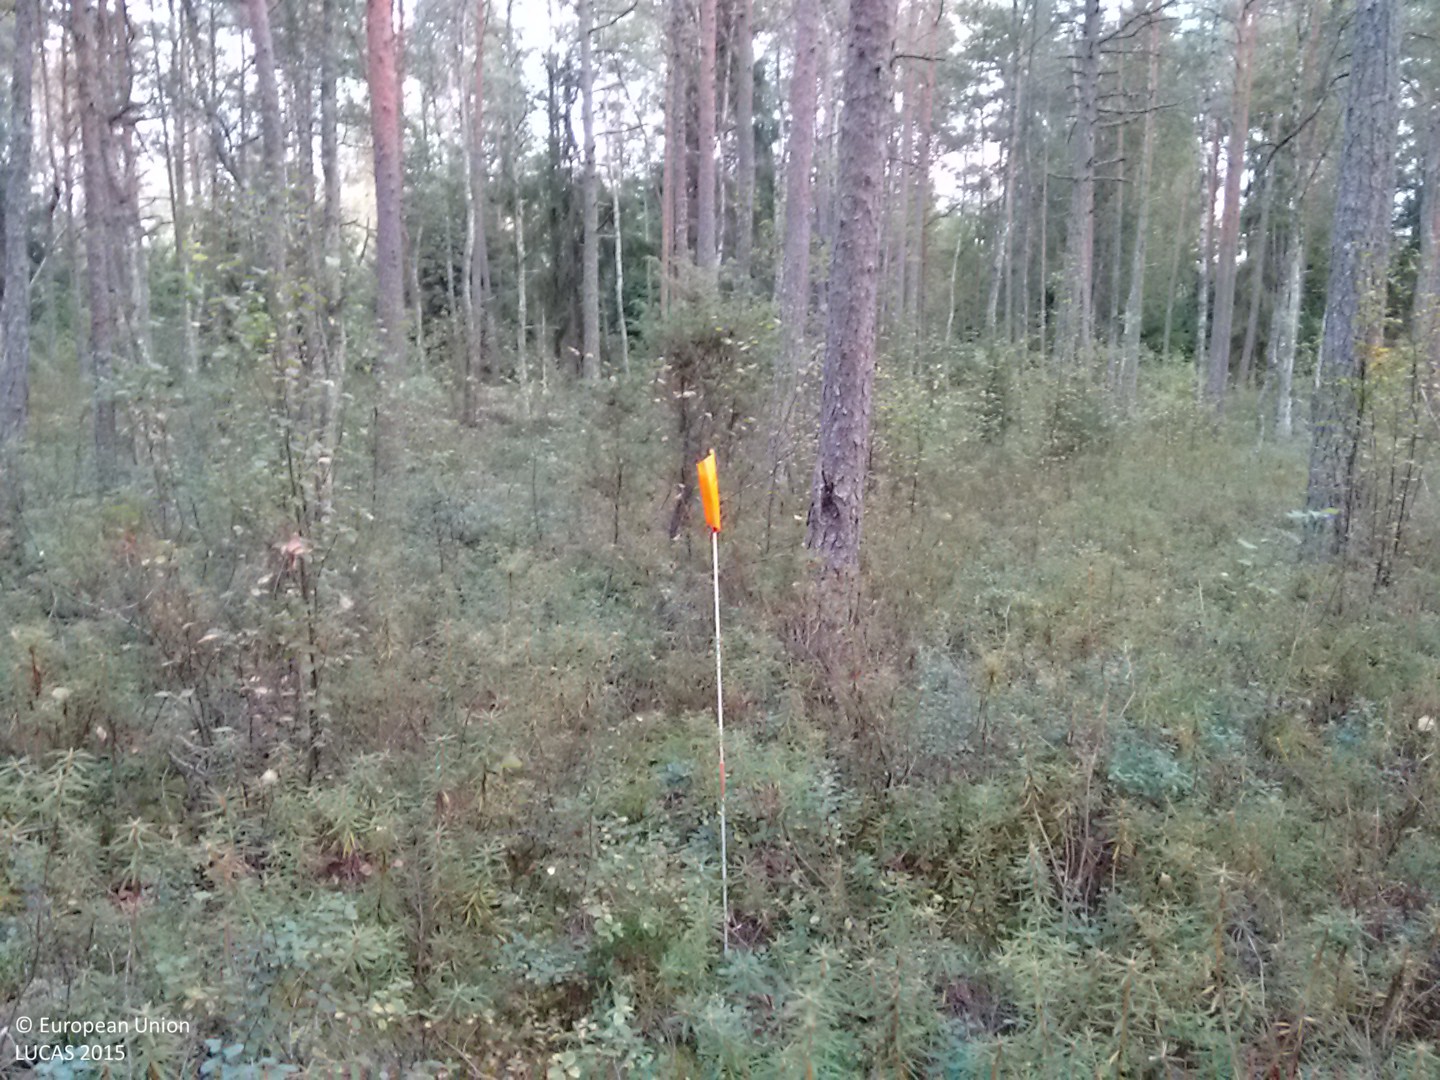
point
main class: Woodland
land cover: Pine dominated mixed woodland
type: hemiboreal forest and nemoral coniferous forest and mixed broadleaved-coniferous forest
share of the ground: > 75 %
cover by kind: coniferous forest trees 60 %, broadleaved forest trees 20 %, shrubs 20 %
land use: Forestry
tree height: > 5 m
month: September
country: FI
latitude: 60.9407
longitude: 21.5904
